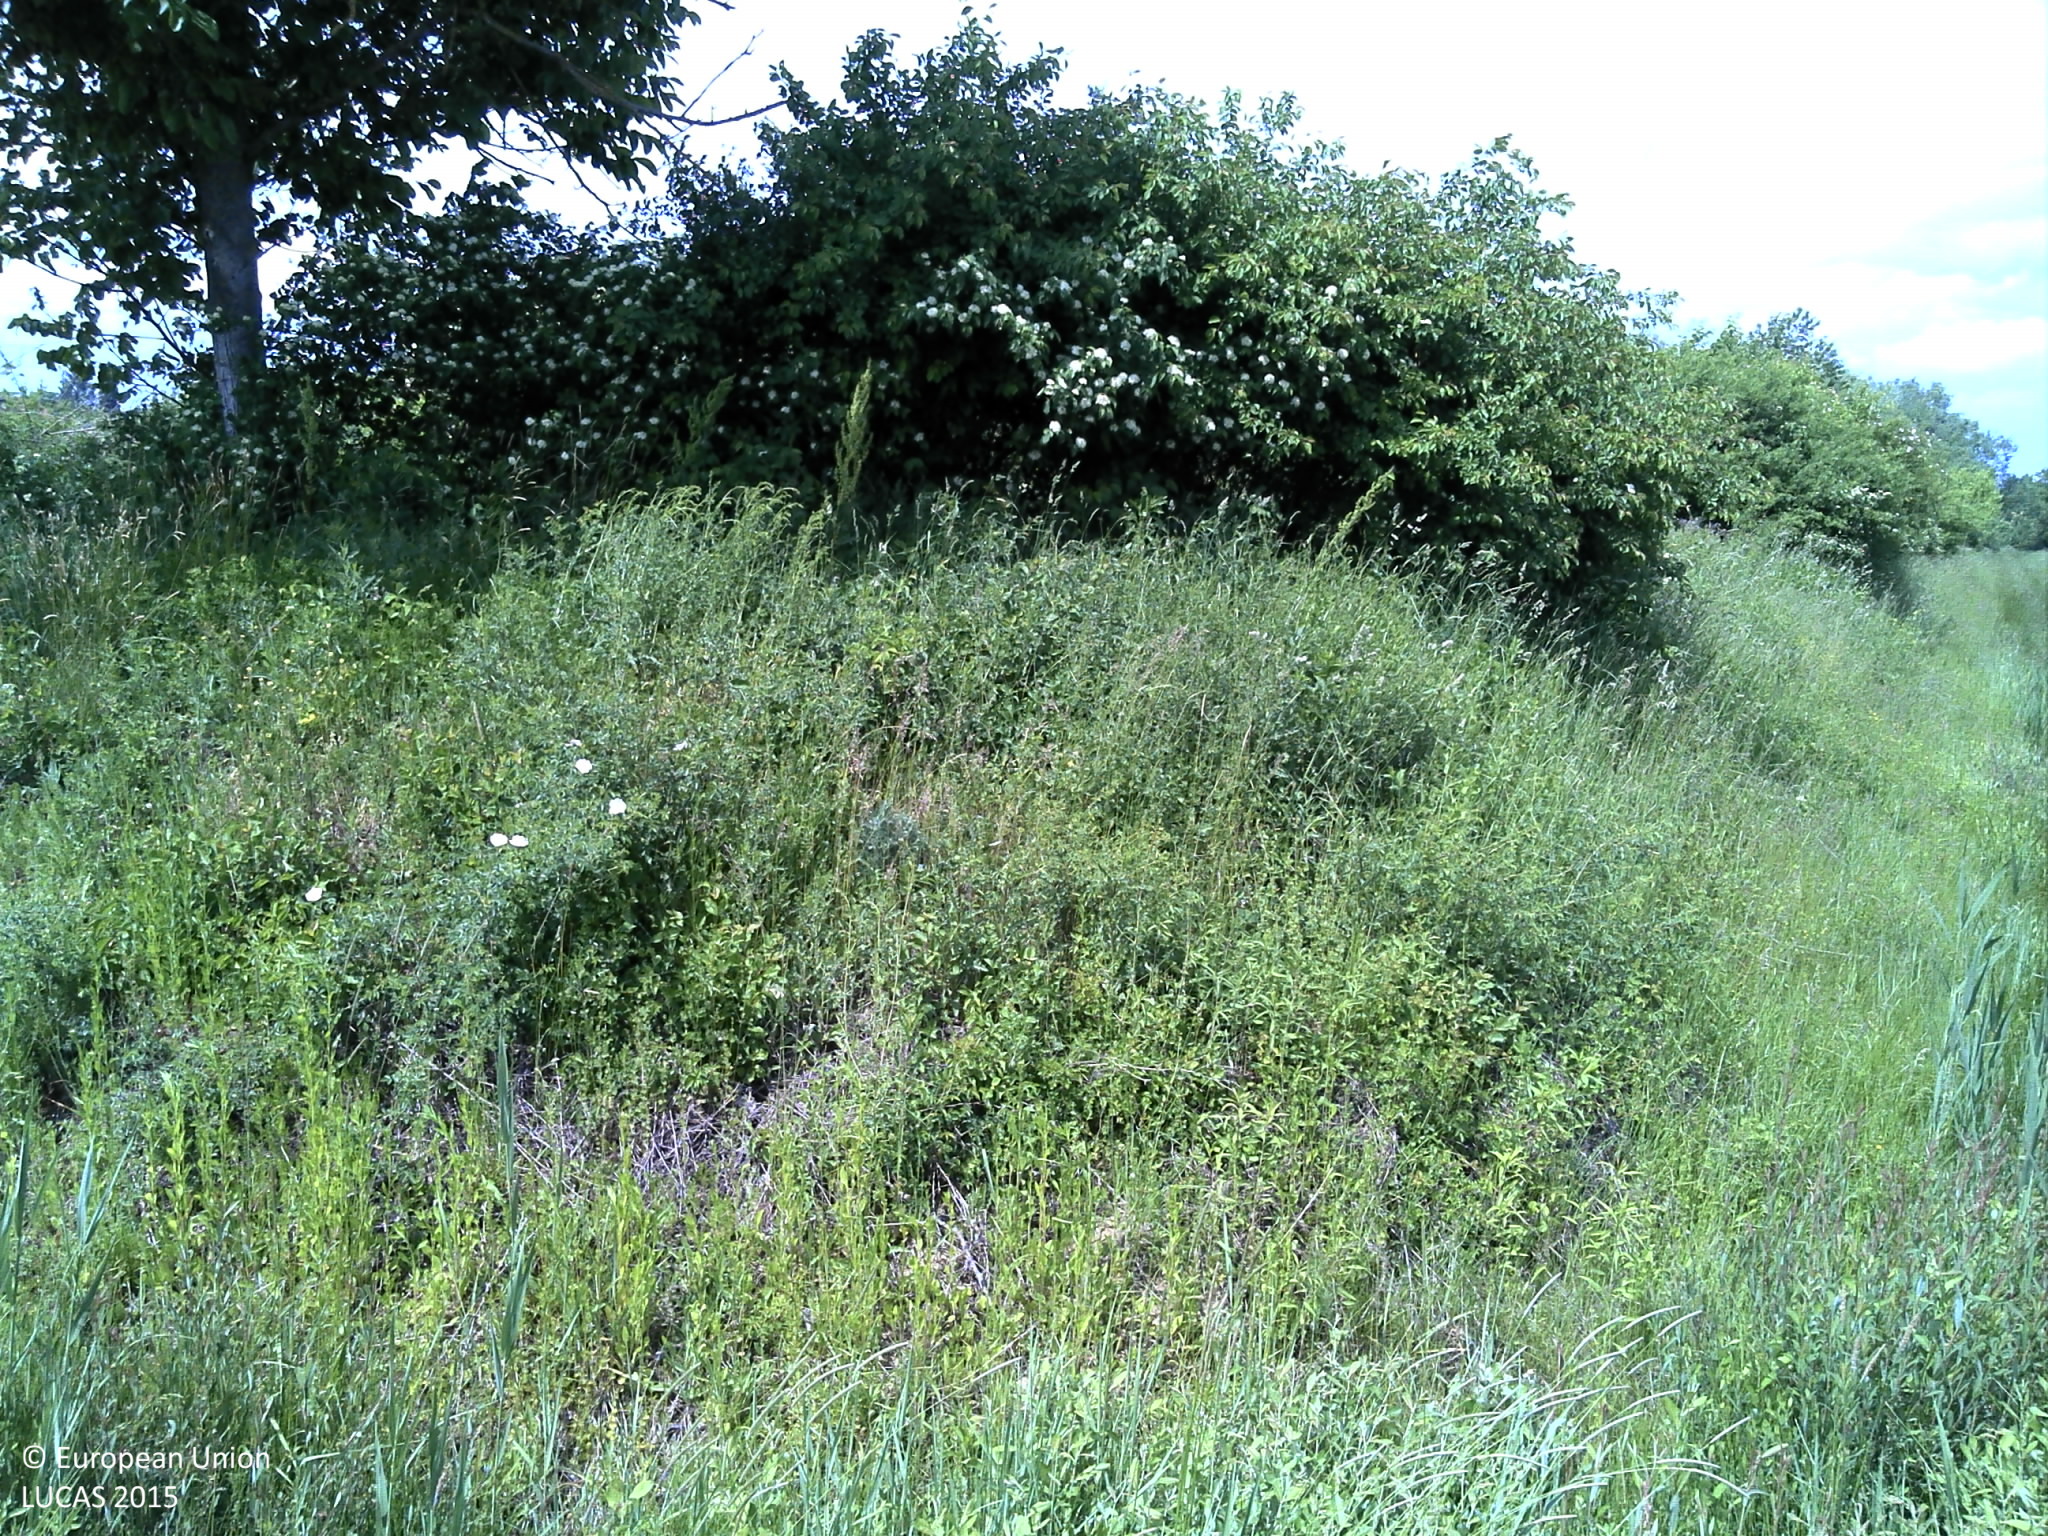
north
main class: Grassland
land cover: Spontaneously vegetated surfaces
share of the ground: > 75 %
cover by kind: herbaceous plants 100 %
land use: Semi-natural and natural areas not in use
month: May
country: HR
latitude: 45.6554
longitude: 18.2057
